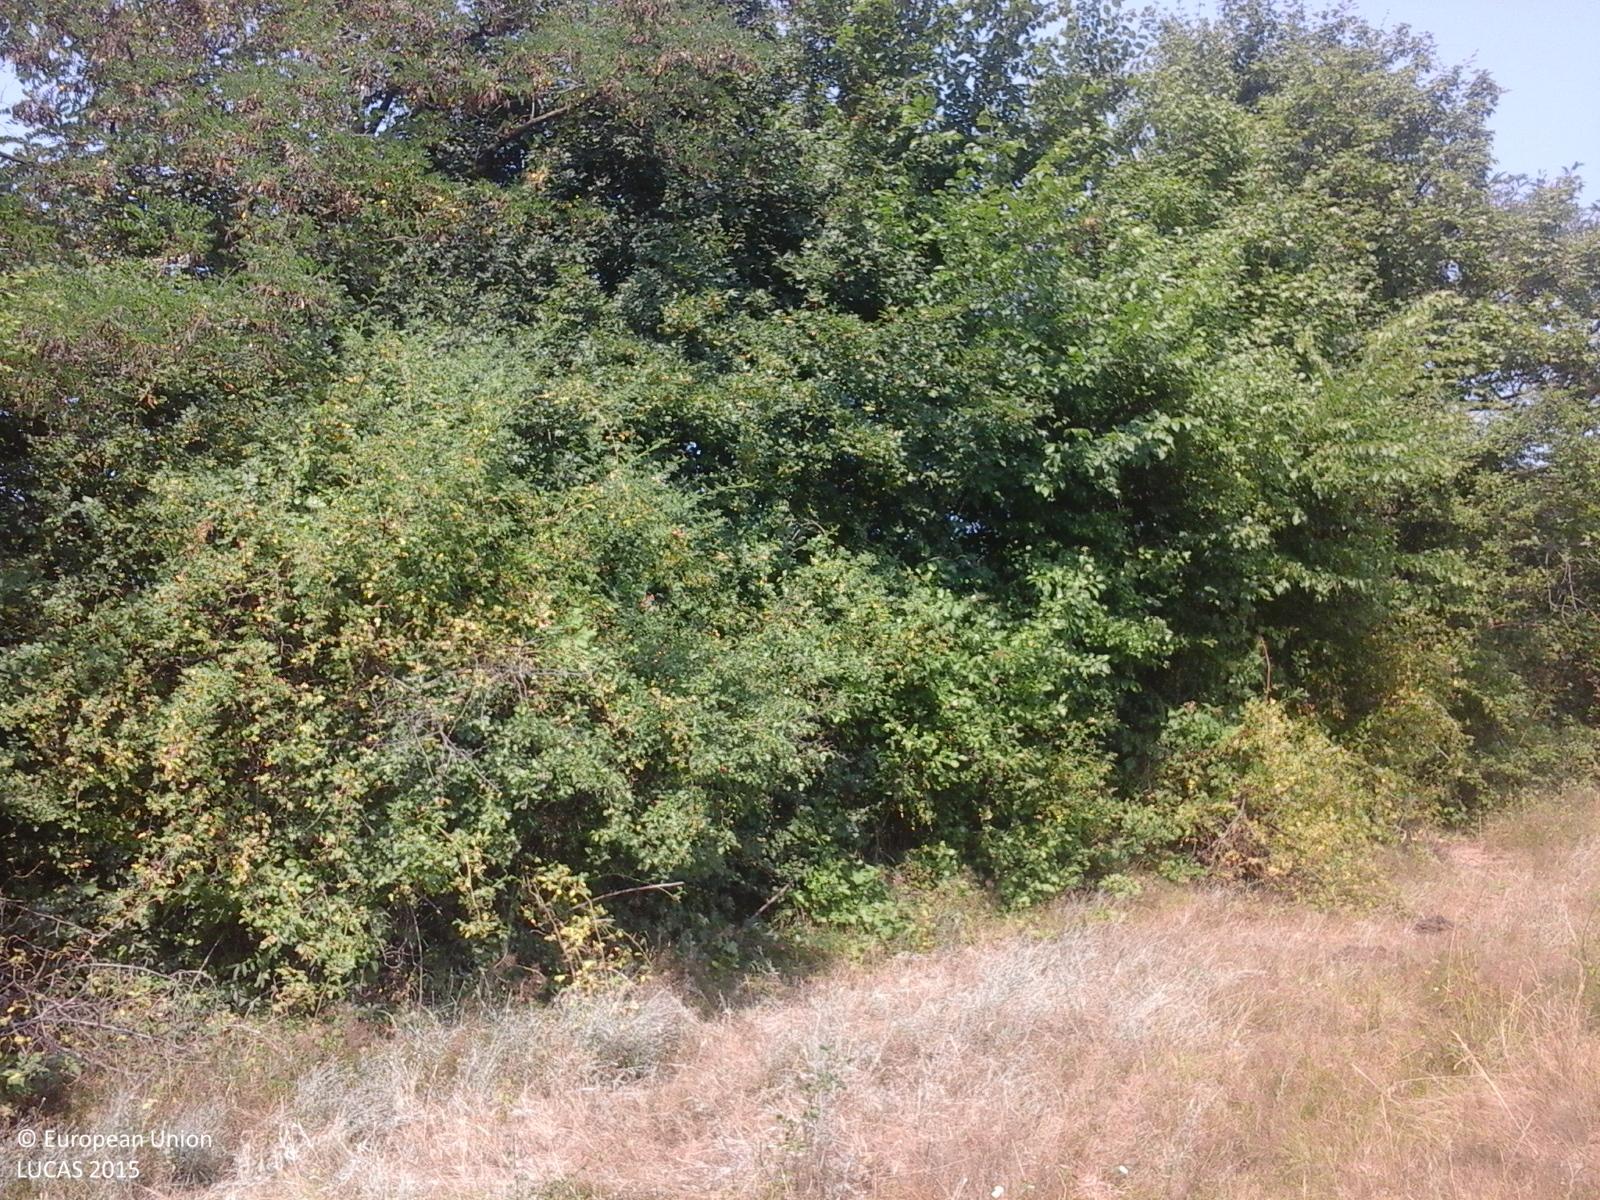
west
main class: Cropland
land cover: Other fruit trees and berries
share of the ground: > 75 %
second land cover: Grassland without tree/shrub cover
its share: > 75 %
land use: Agriculture (excluding fallow land and kitchen gardens)
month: July
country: RO
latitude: 45.1818
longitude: 24.5735
